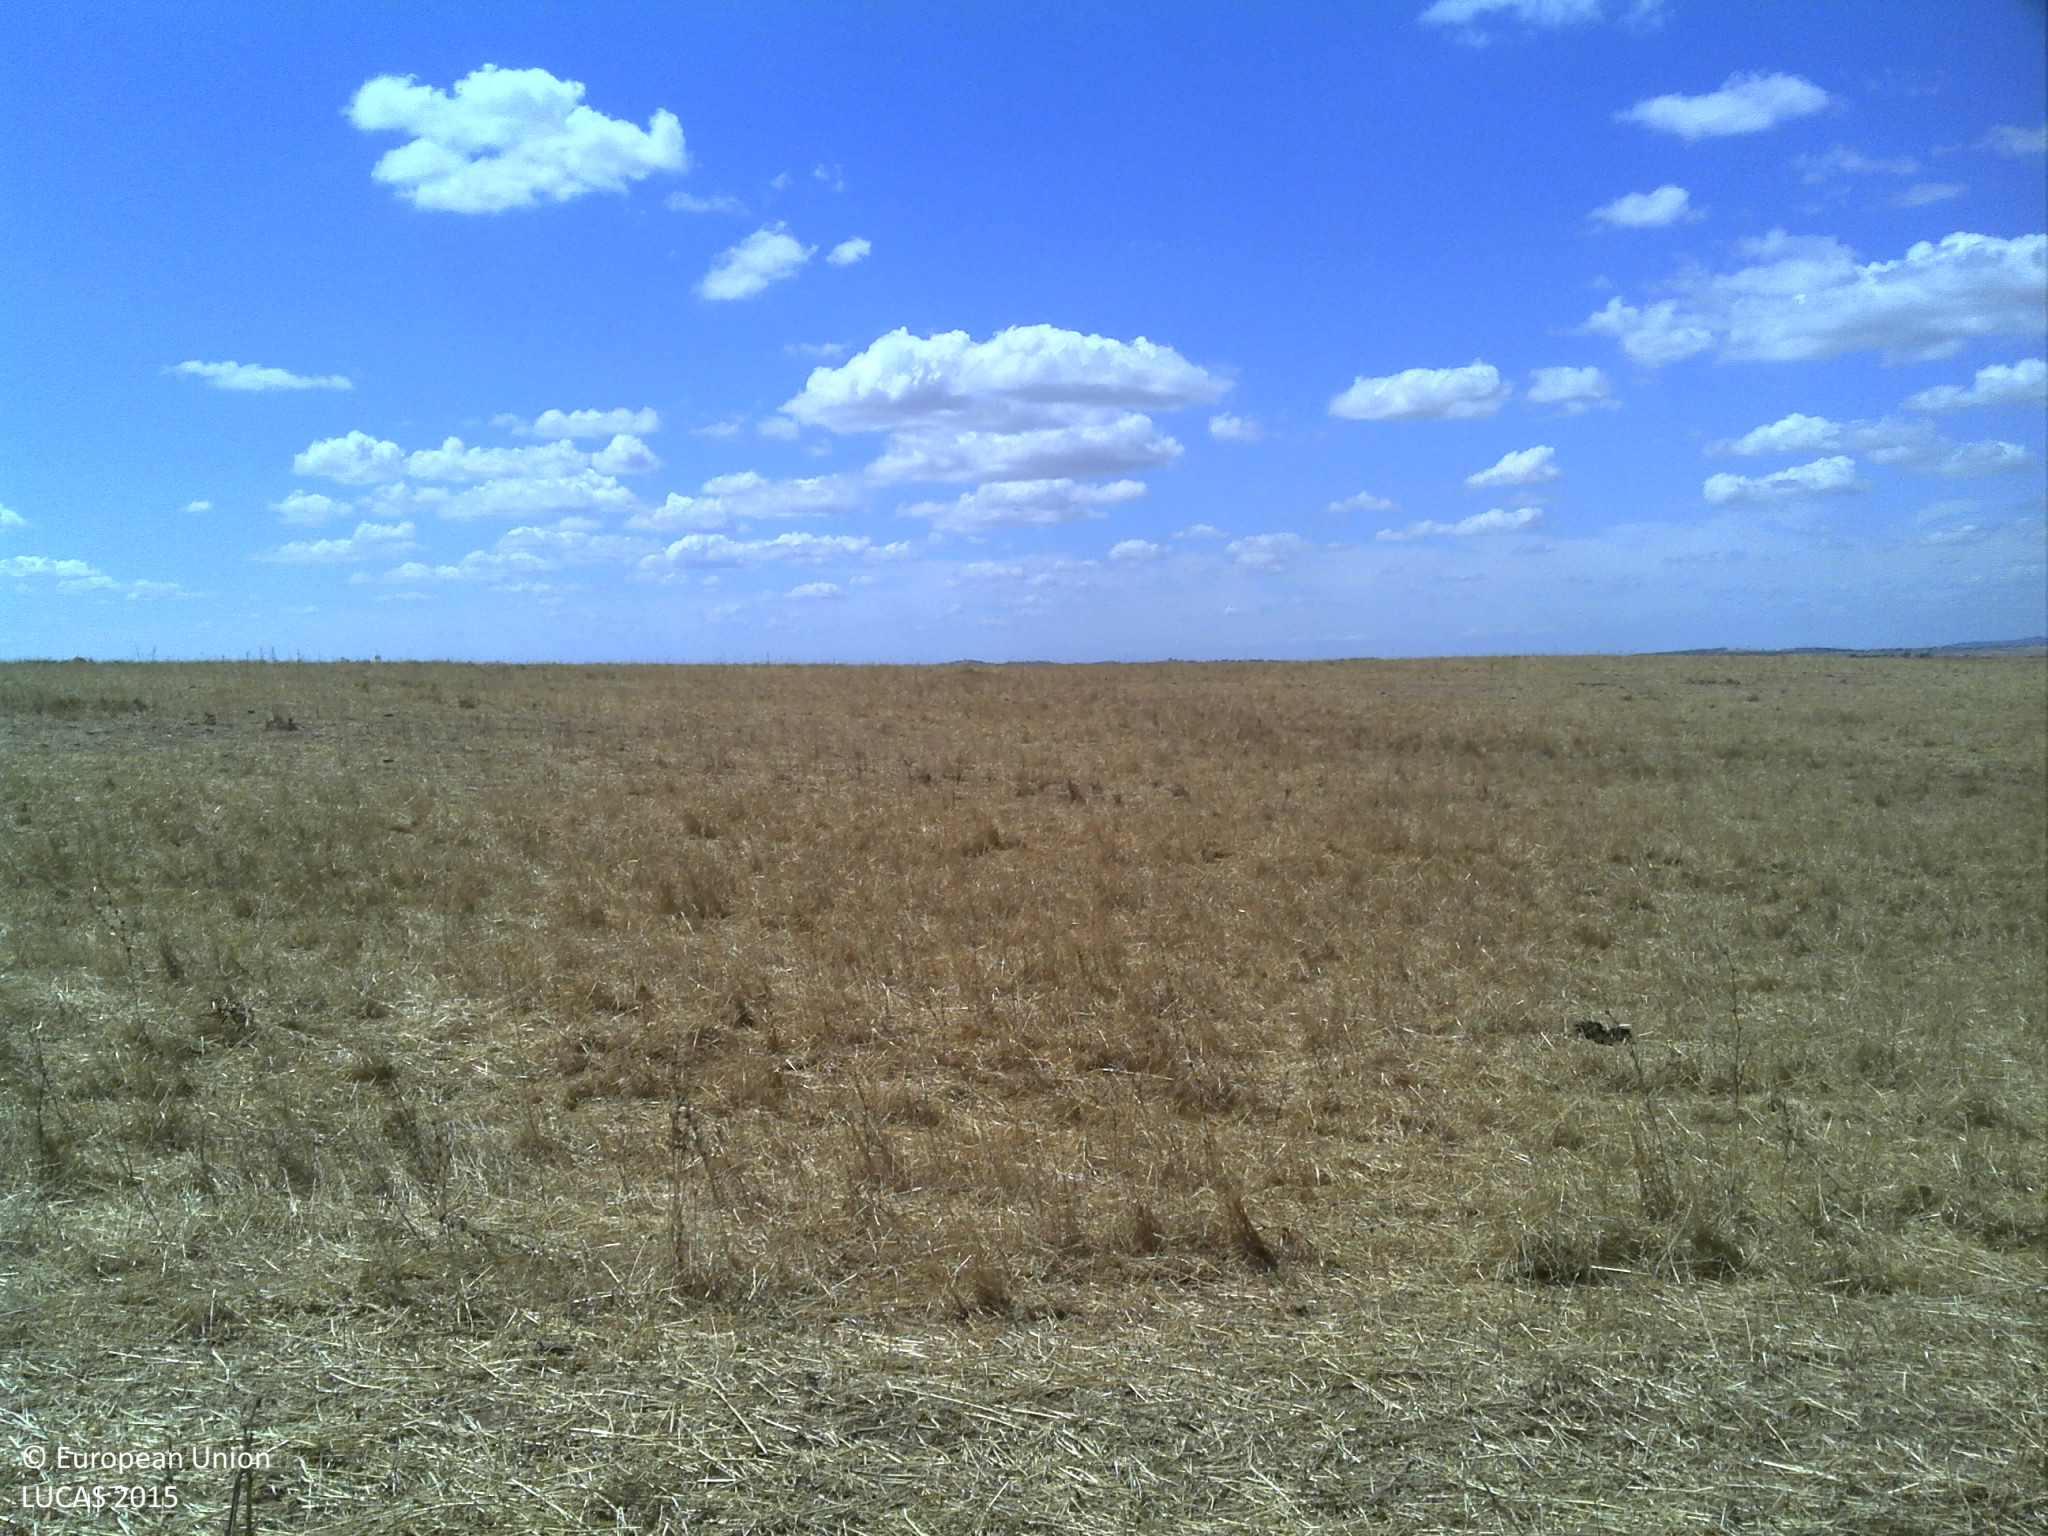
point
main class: Grassland
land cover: Grassland without tree/shrub cover
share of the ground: > 75 %
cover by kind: herbaceous plants 85 %, unconsolidated bare surface 15 %
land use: Agriculture (excluding fallow land and kitchen gardens)
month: July
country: PT
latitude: 38.0755
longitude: -7.8695
